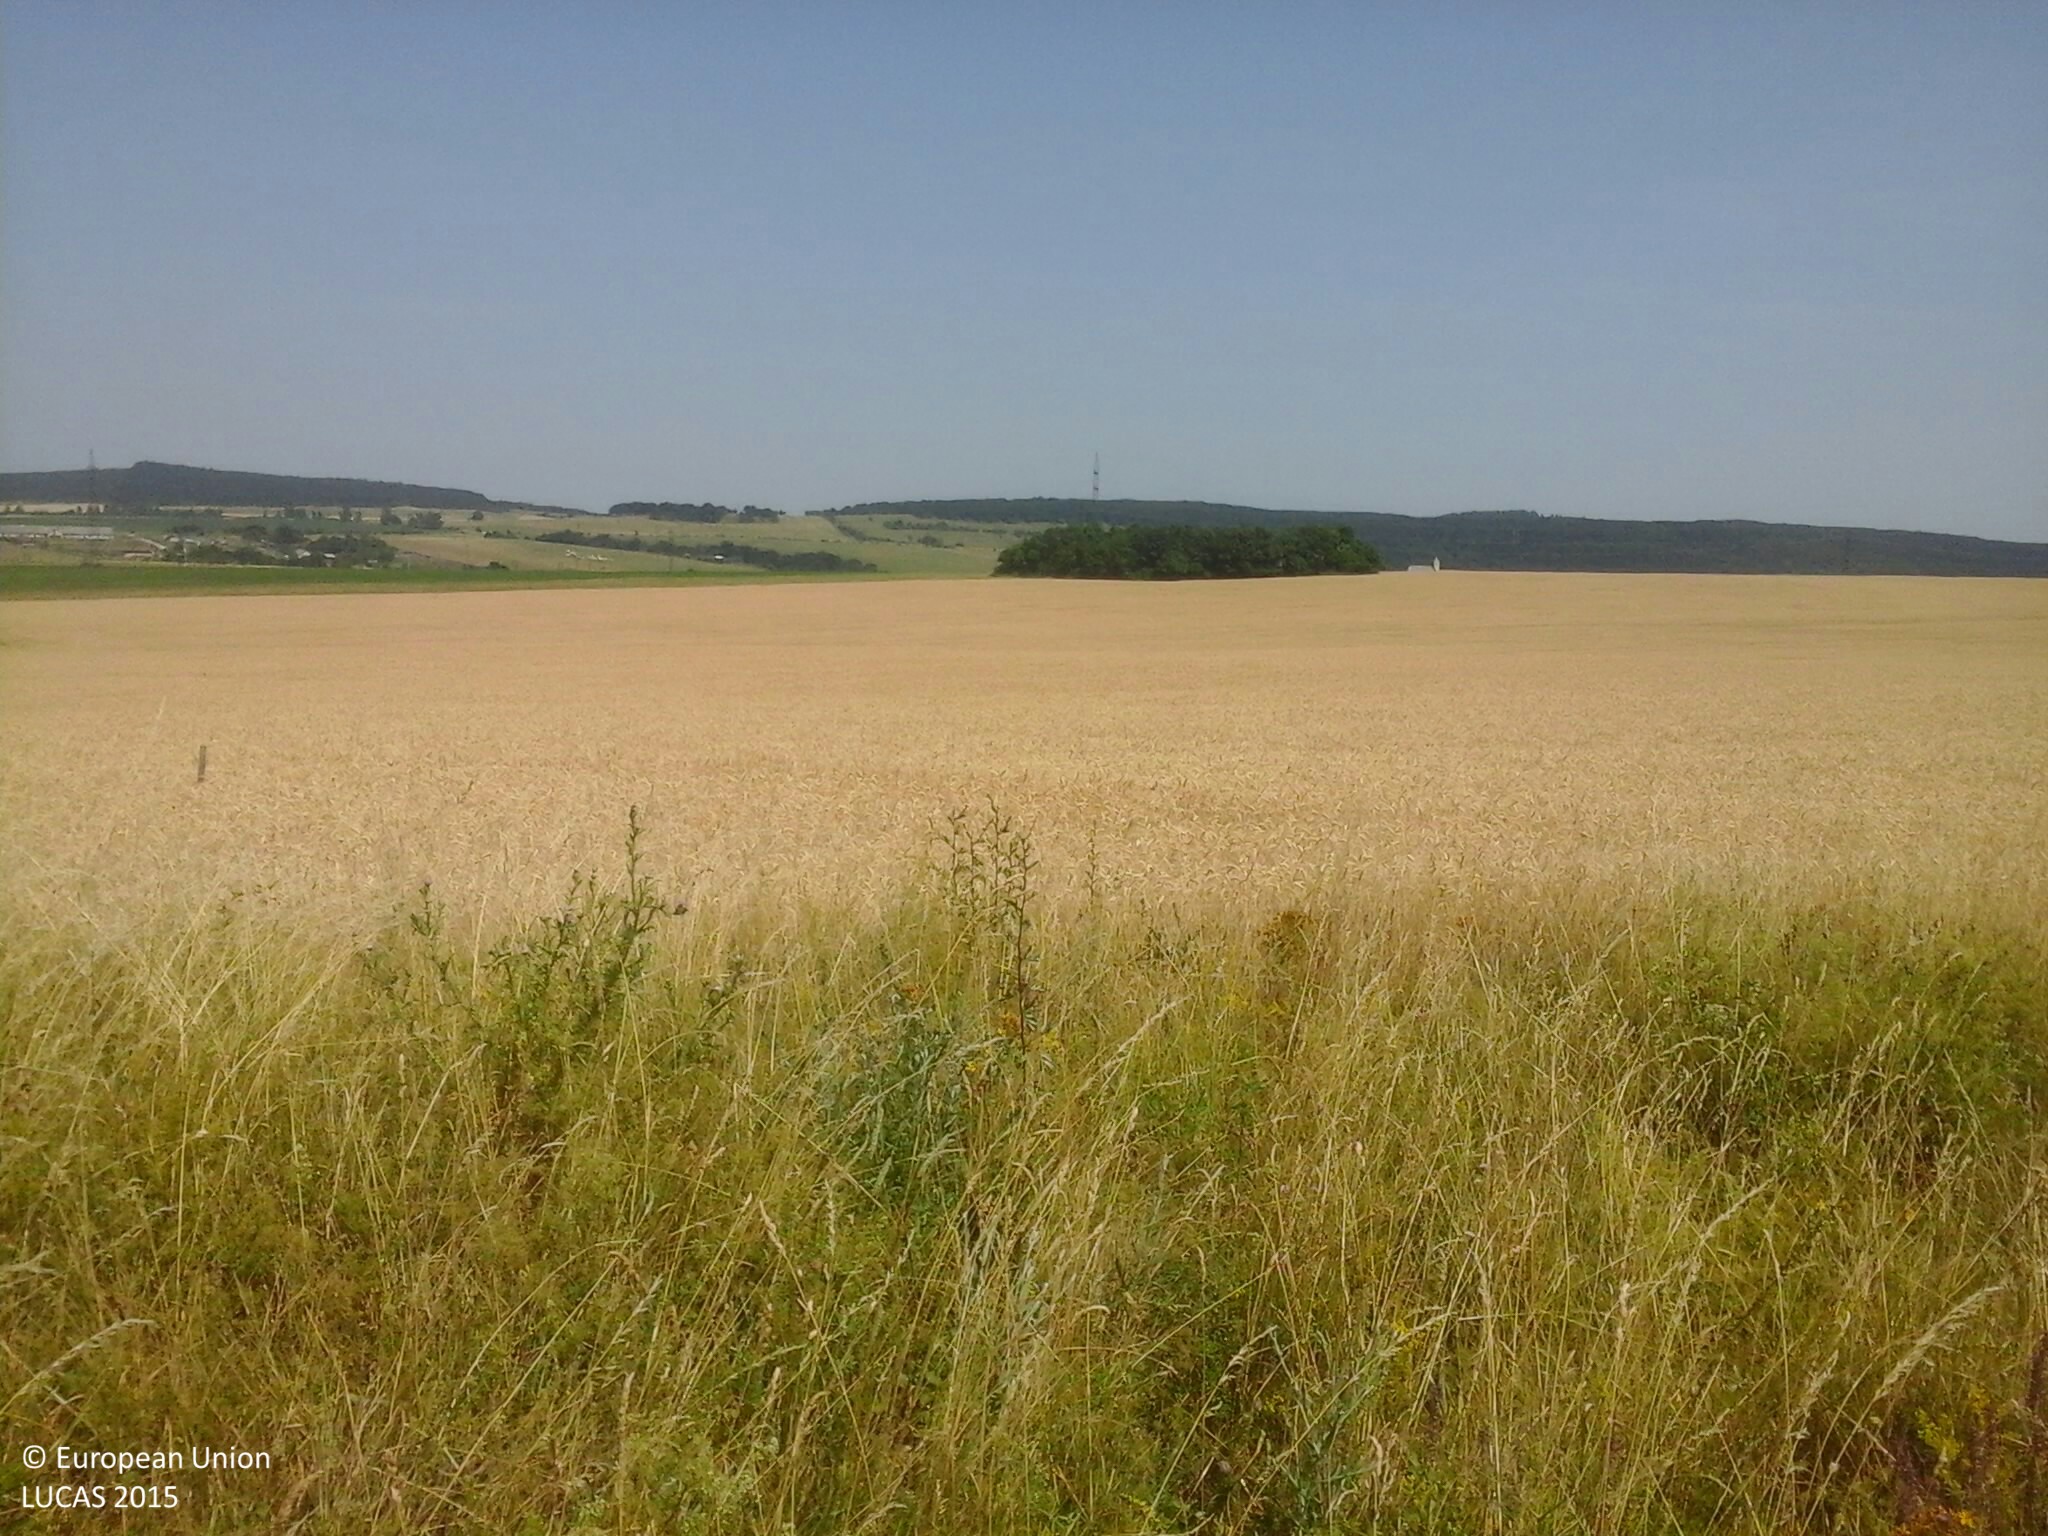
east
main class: Grassland
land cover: Grassland with sparse tree/shrub cover
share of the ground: > 75 %
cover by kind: herbaceous plants 90 %, broadleaved forest trees 5 %, shrubs 5 %
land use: Agriculture (excluding fallow land and kitchen gardens)
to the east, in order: Grassland with sparse tree/shrub cover; Common wheat
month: July
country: HU
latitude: 47.0062
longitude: 17.8076
